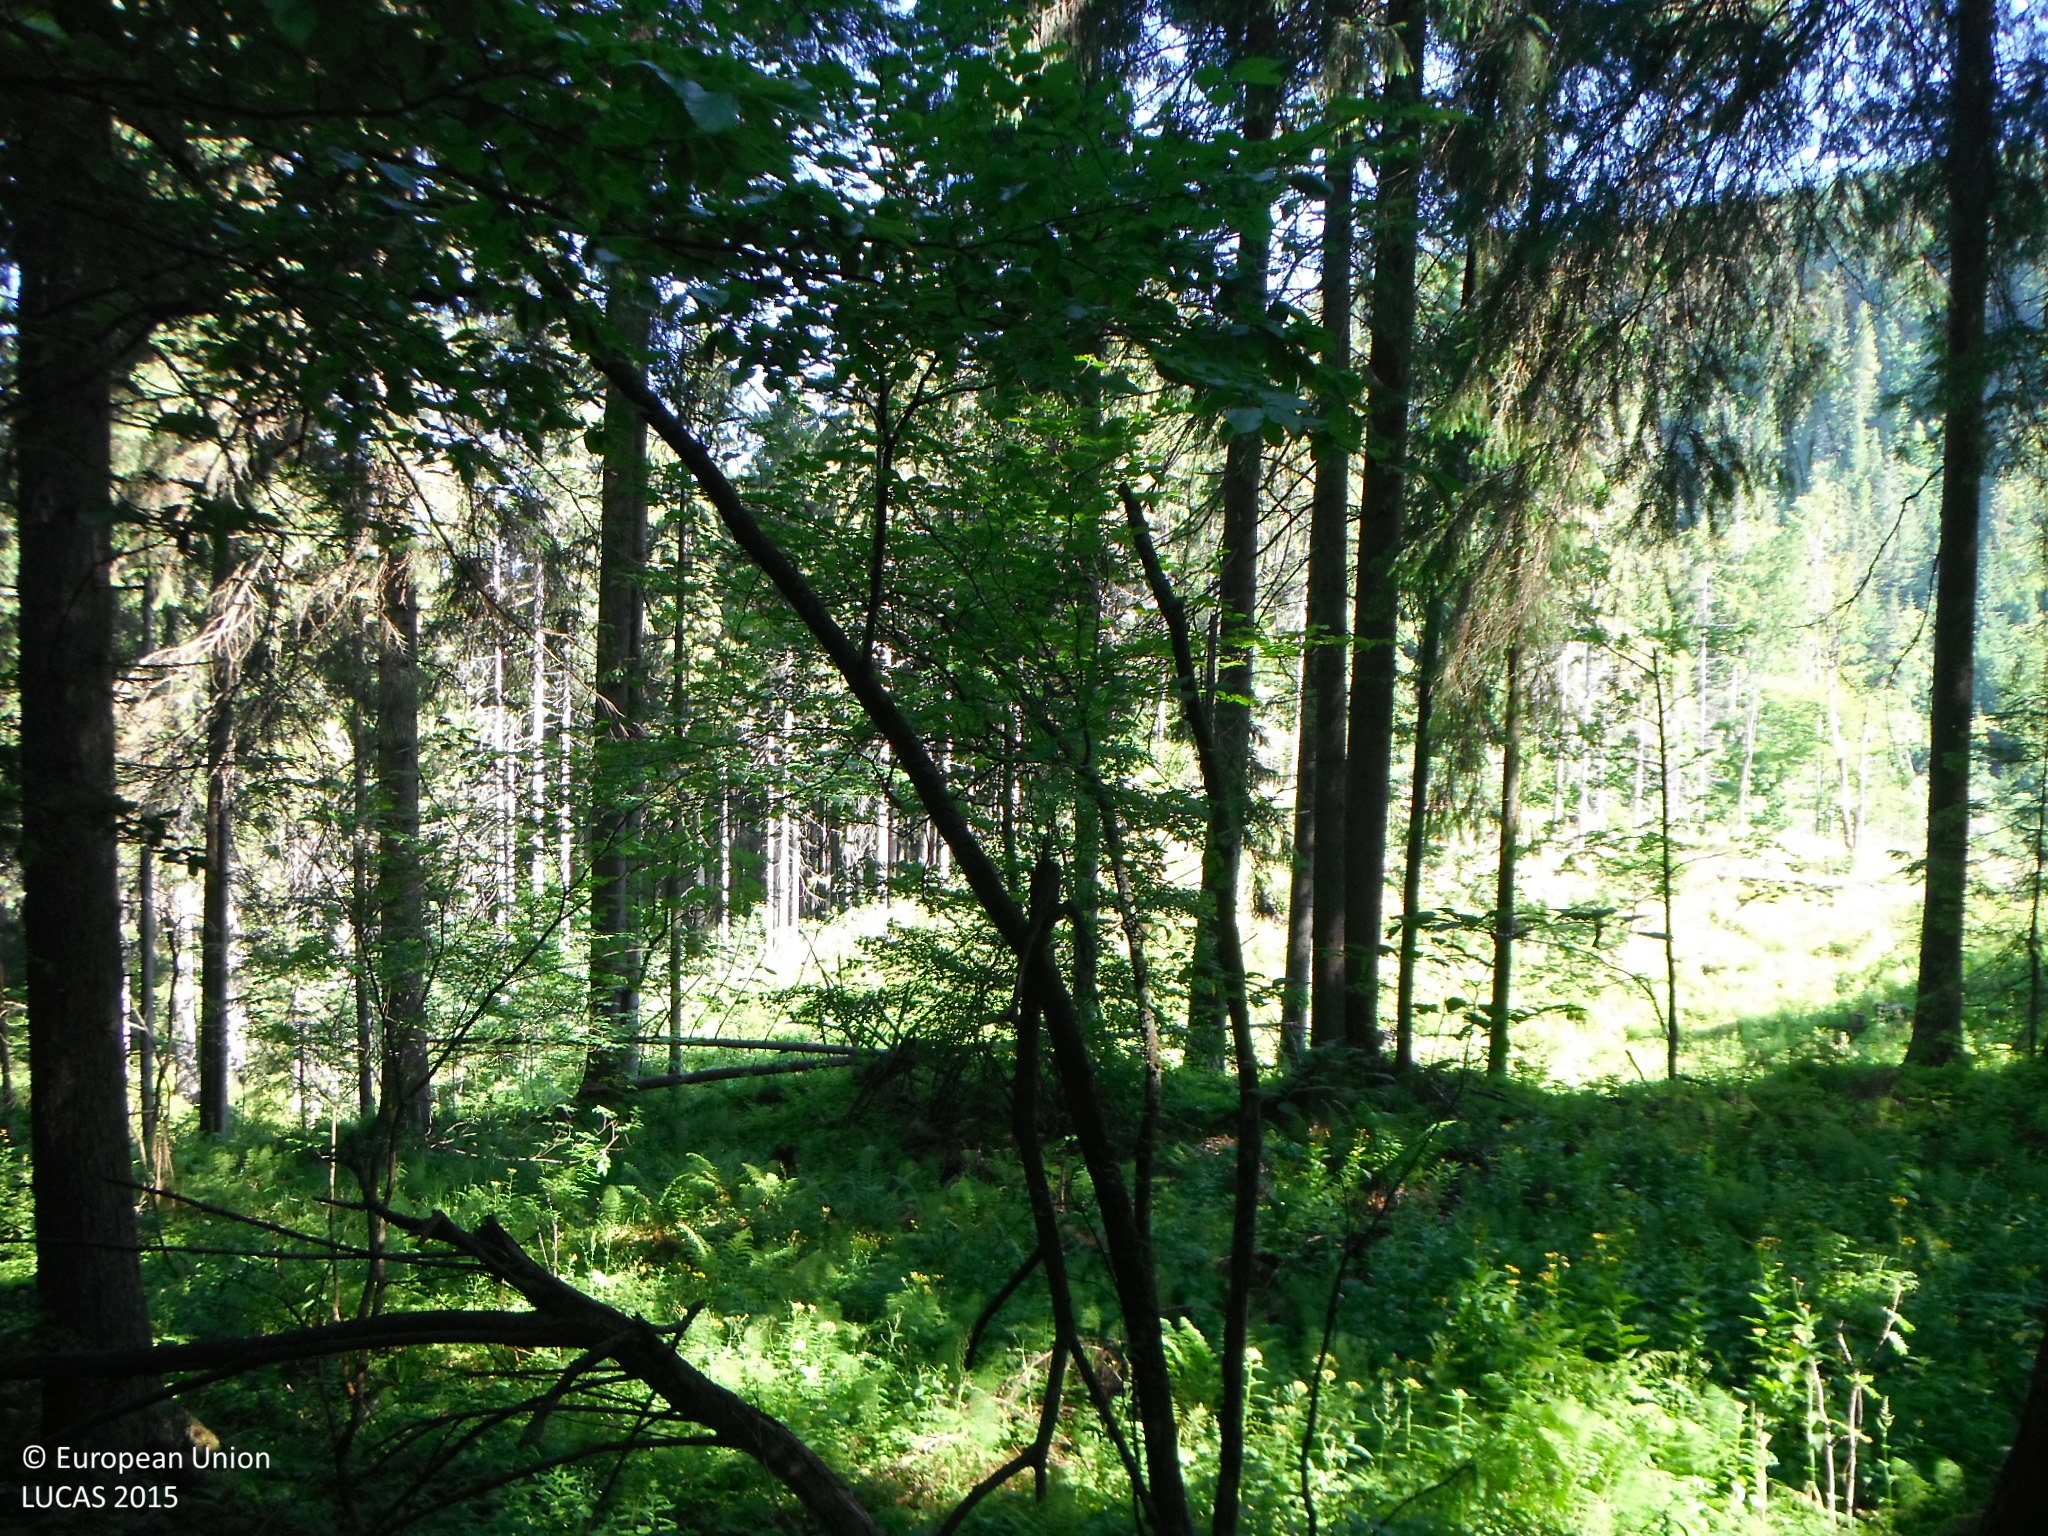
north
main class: Woodland
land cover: Spruce dominated coniferous woodland
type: alpine coniferous forest
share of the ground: > 75 %
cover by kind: coniferous forest trees 95 %, broadleaved forest trees 5 %
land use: Forestry
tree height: > 5 m
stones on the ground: < 10 %
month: July
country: SK
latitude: 49.2396
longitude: 19.5451
